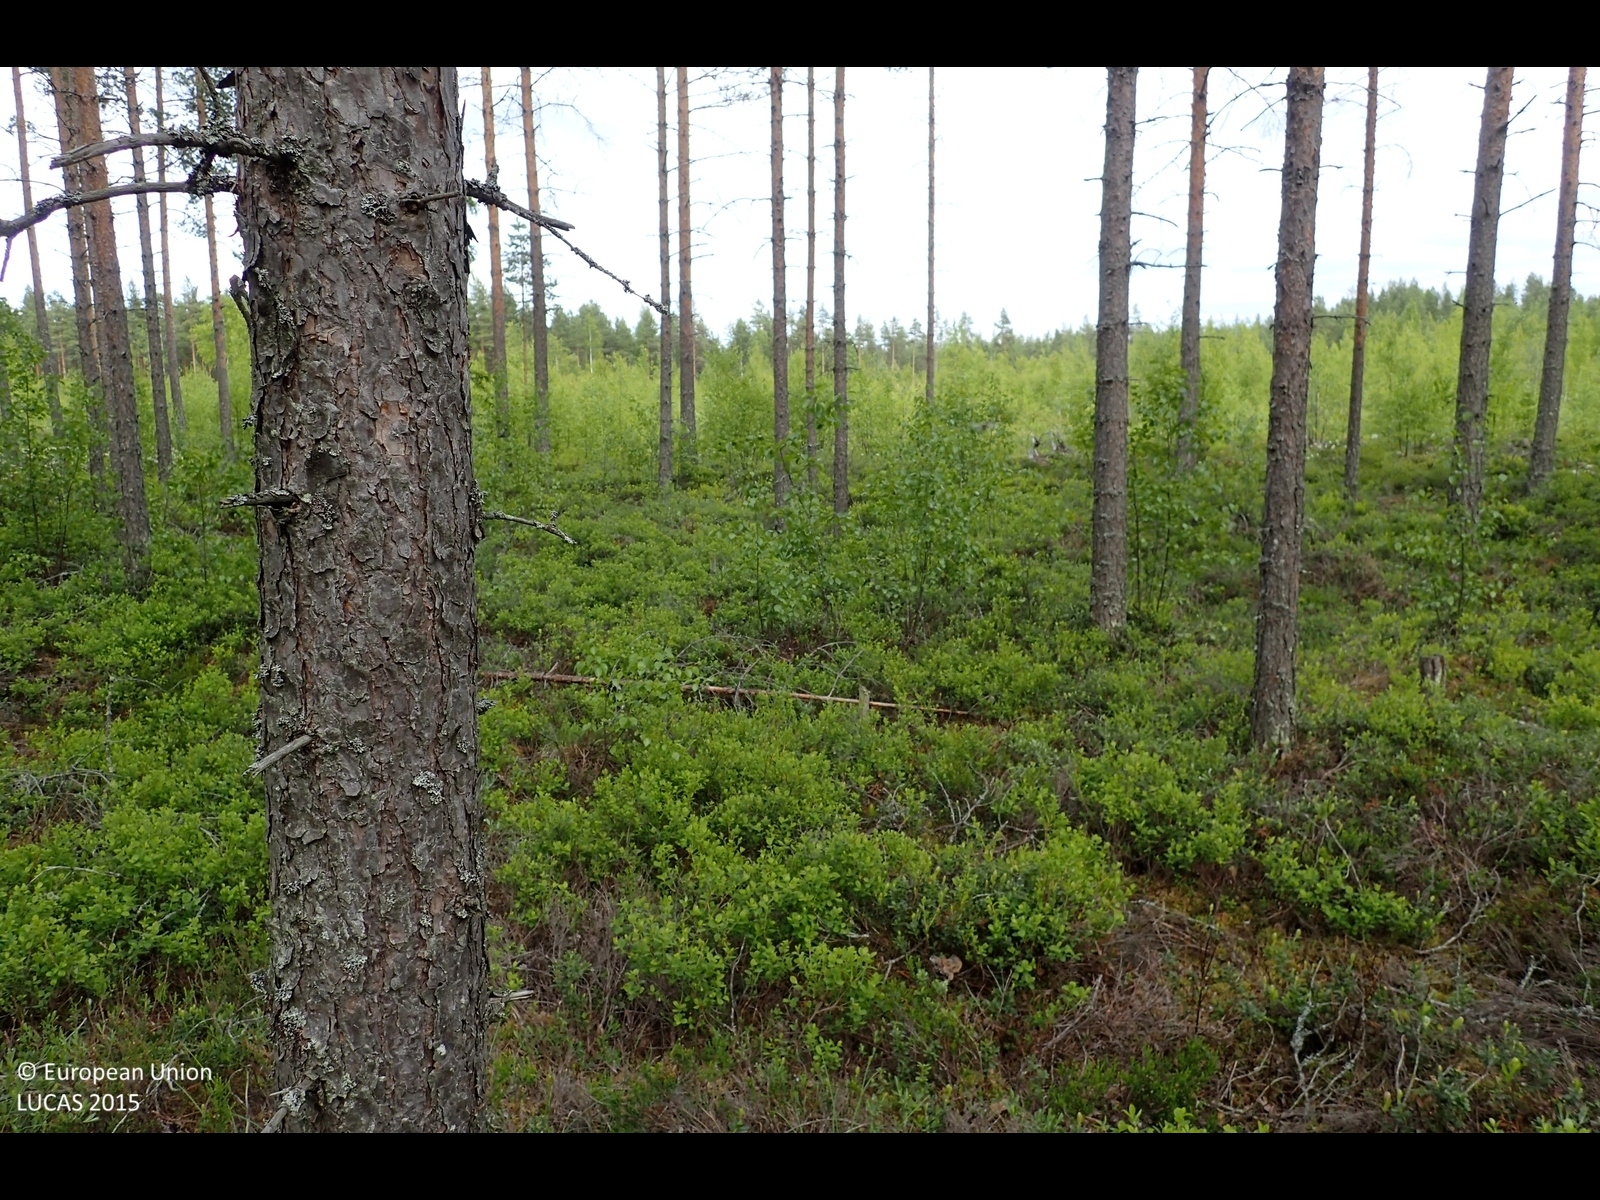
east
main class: Woodland
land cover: Pine dominated coniferous woodland
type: boreal forest
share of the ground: 25 - 50 %
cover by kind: shrubs 60 %, coniferous forest trees 35 %, broadleaved forest trees 5 %
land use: Forestry
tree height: > 5 m
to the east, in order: Pine dominated coniferous woodland; Broadleaved woodland; Ditches and canals; Broadleaved woodland; Ditches and canals; Broadleaved woodland; Ditches and canals; Broadleaved woodland; Ditches and canals; Broadleaved woodland; Ditches and canals; Broadleaved woodland; Ditches and canals; Broadleaved woodland; Ditches and canals; Broadleaved woodland; Ditches and canals; Pine dominated mixed woodland; Ditches and canals; Pine dominated mixed woodland; Ditches and canals; Pine dominated coniferous woodland
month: June
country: FI
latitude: 62.4045
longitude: 23.0882
